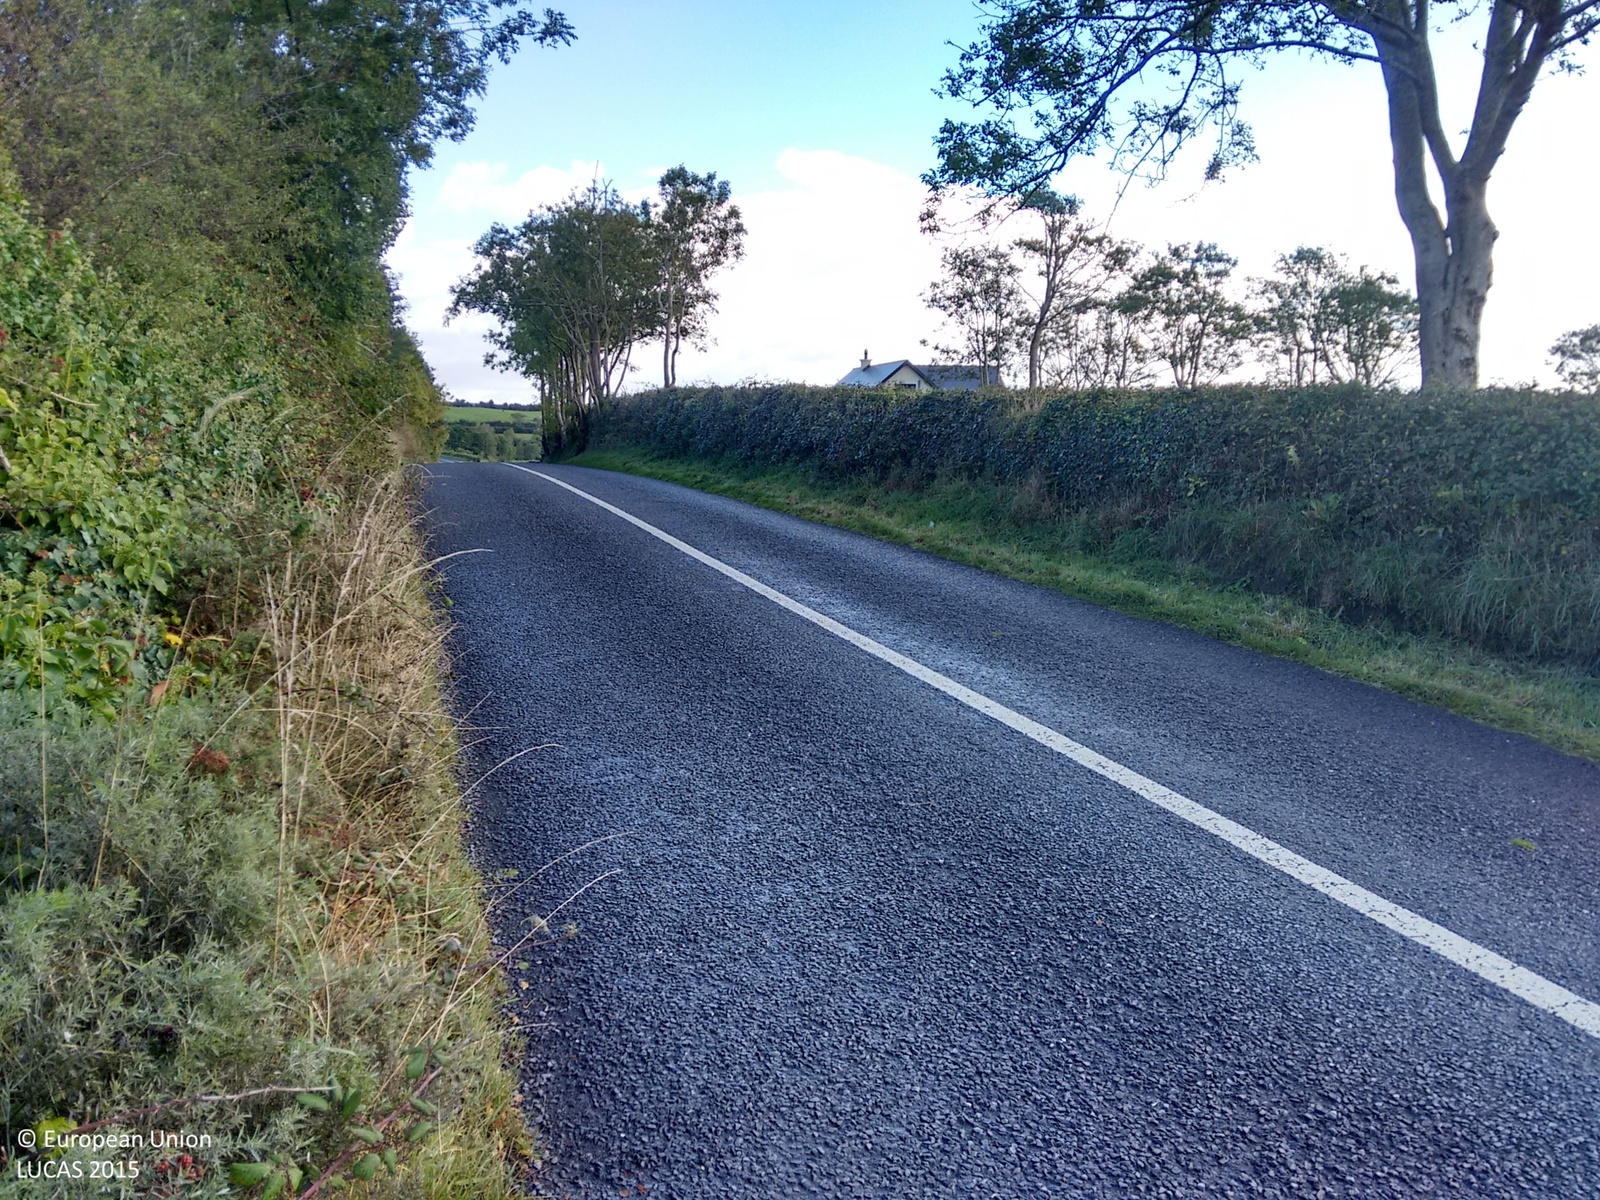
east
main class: Grassland
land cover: Grassland without tree/shrub cover
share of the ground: > 75 %
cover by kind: herbaceous plants 100 %
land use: Agriculture (excluding fallow land and kitchen gardens)
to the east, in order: Grassland without tree/shrub cover; Broadleaved woodland; Grassland without tree/shrub cover; Ditches and canals; Grassland without tree/shrub cover
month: September
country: IE
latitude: 52.6253
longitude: -9.1734
